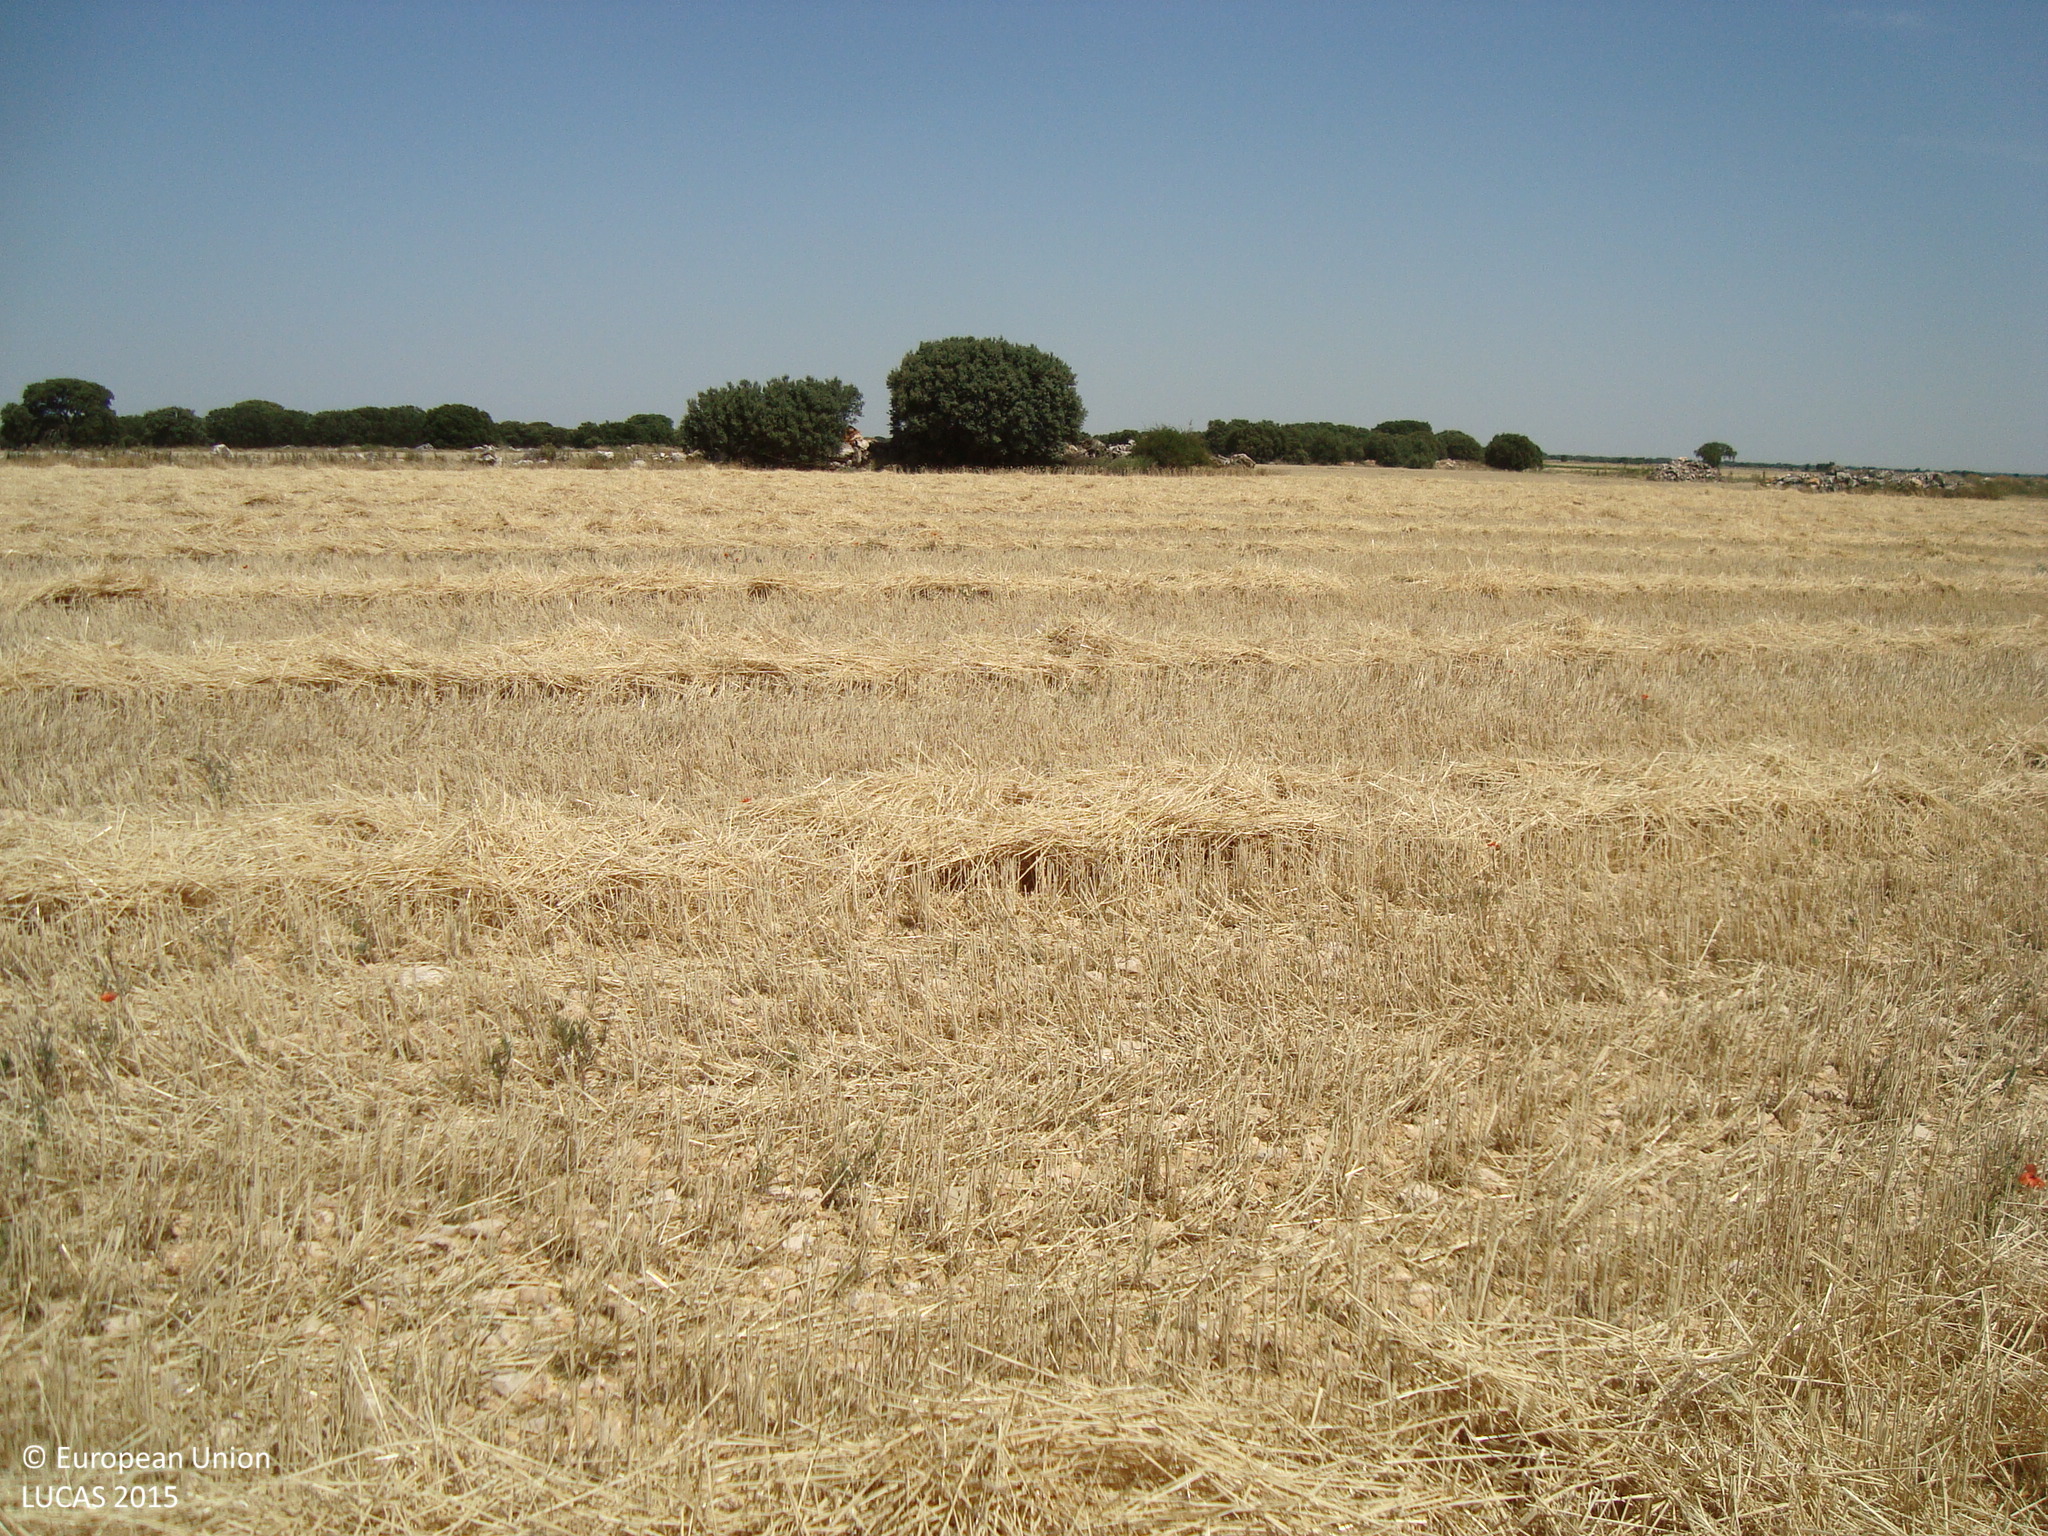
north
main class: Cropland
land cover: Common wheat
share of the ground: > 75 %
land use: Agriculture (excluding fallow land and kitchen gardens)
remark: Harvested field
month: July
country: ES
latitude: 41.8252
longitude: -4.1116
